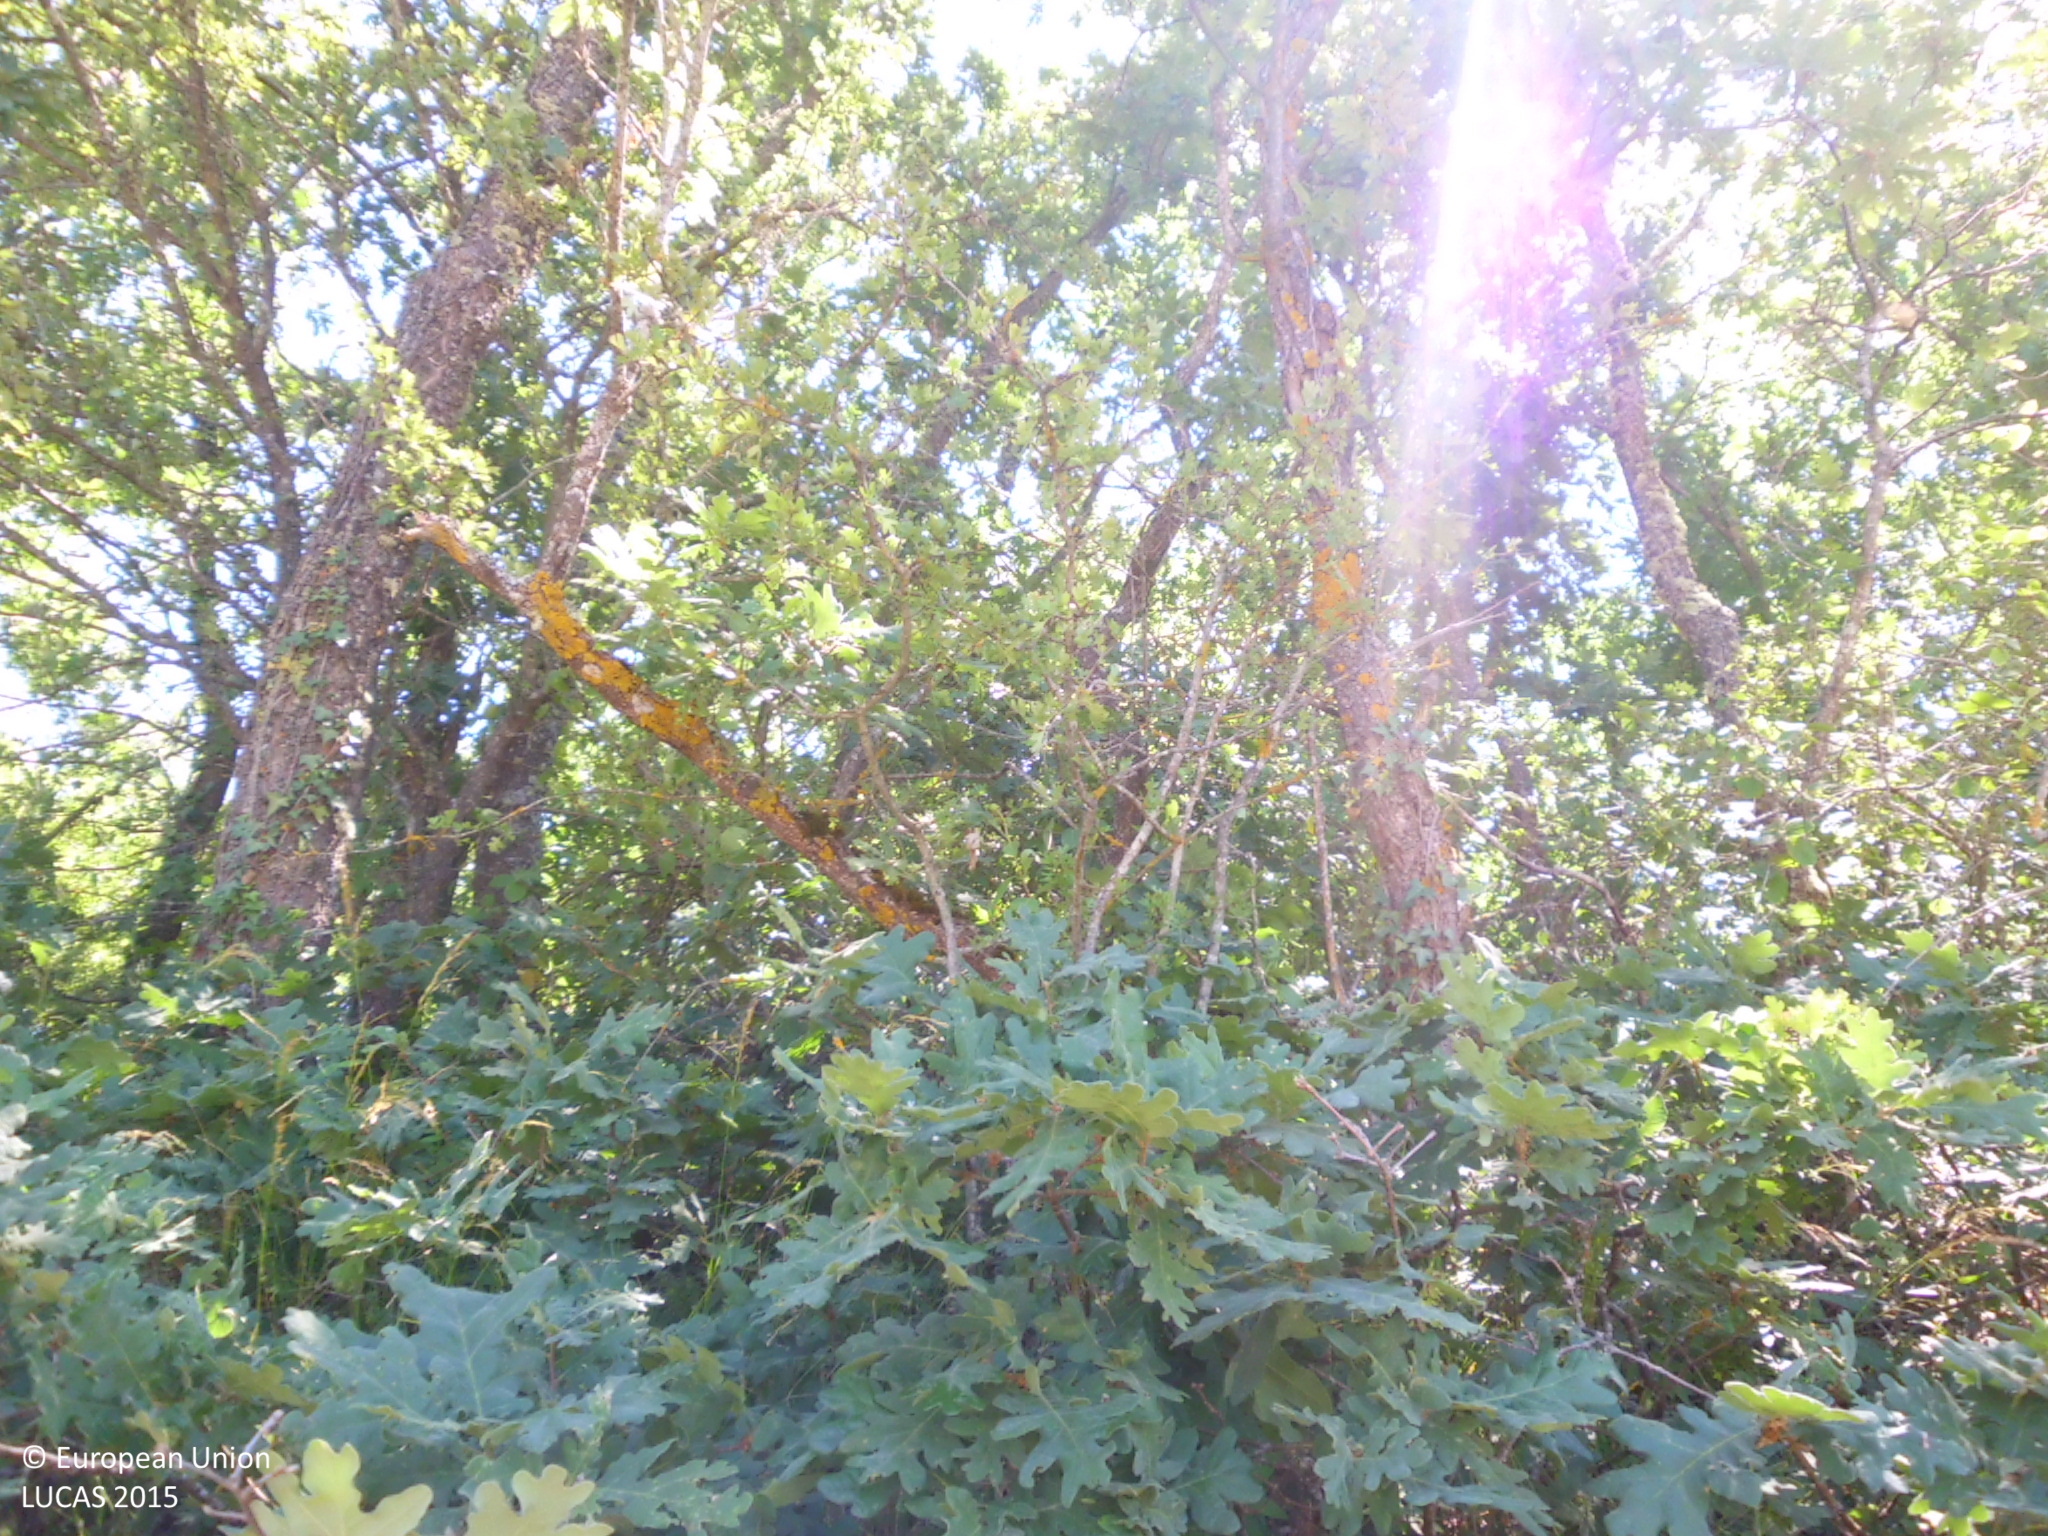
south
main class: Woodland
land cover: Broadleaved woodland
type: mesophytic deciduous forest
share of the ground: 50 - 75 %
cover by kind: broadleaved forest trees 50 %, herbaceous plants 20 %, consolidated bare surface 20 %, shrubs 10 %
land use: Semi-natural and natural areas not in use
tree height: > 5 m
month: July
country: ES
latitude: 42.7974
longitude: -4.0957
